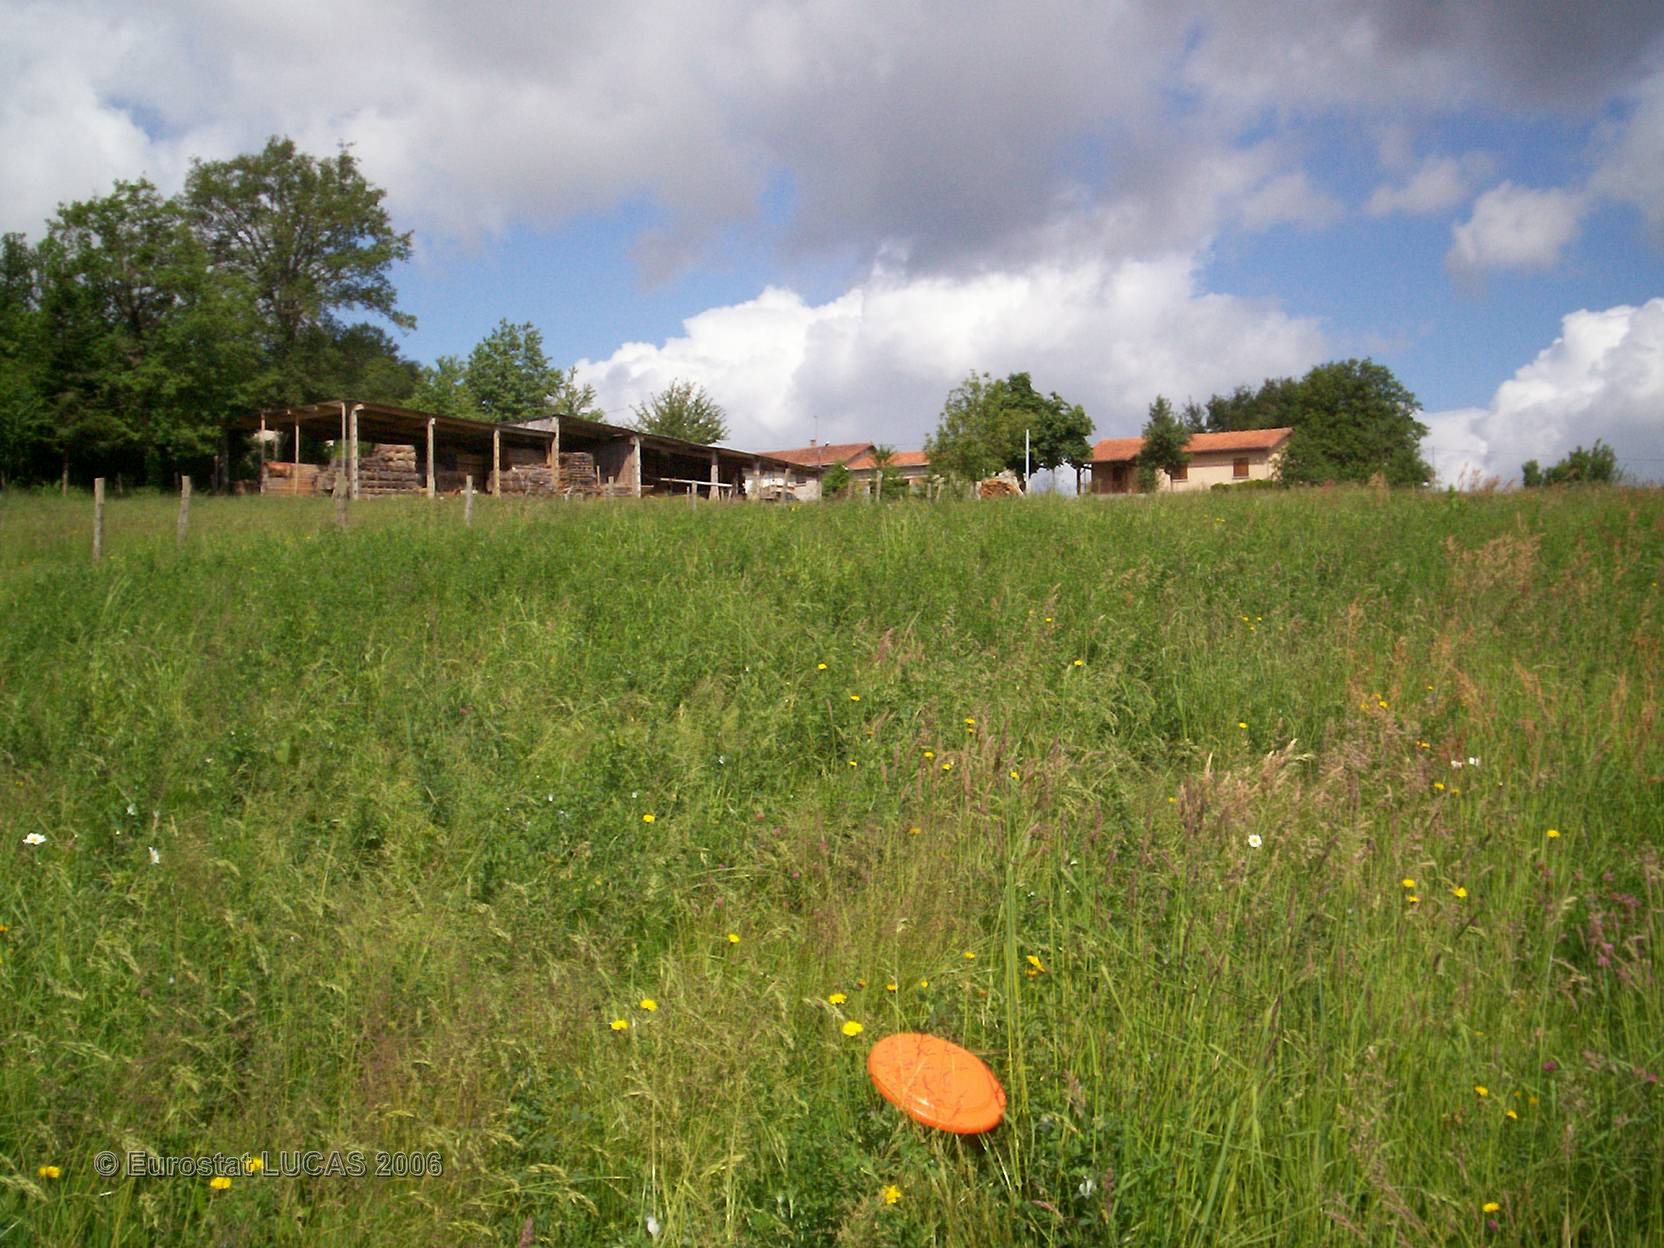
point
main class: Cropland
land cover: Lucerne
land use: Agriculture (excluding fallow land and kitchen gardens)
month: May
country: FR
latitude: 46.0690
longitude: 0.6642
